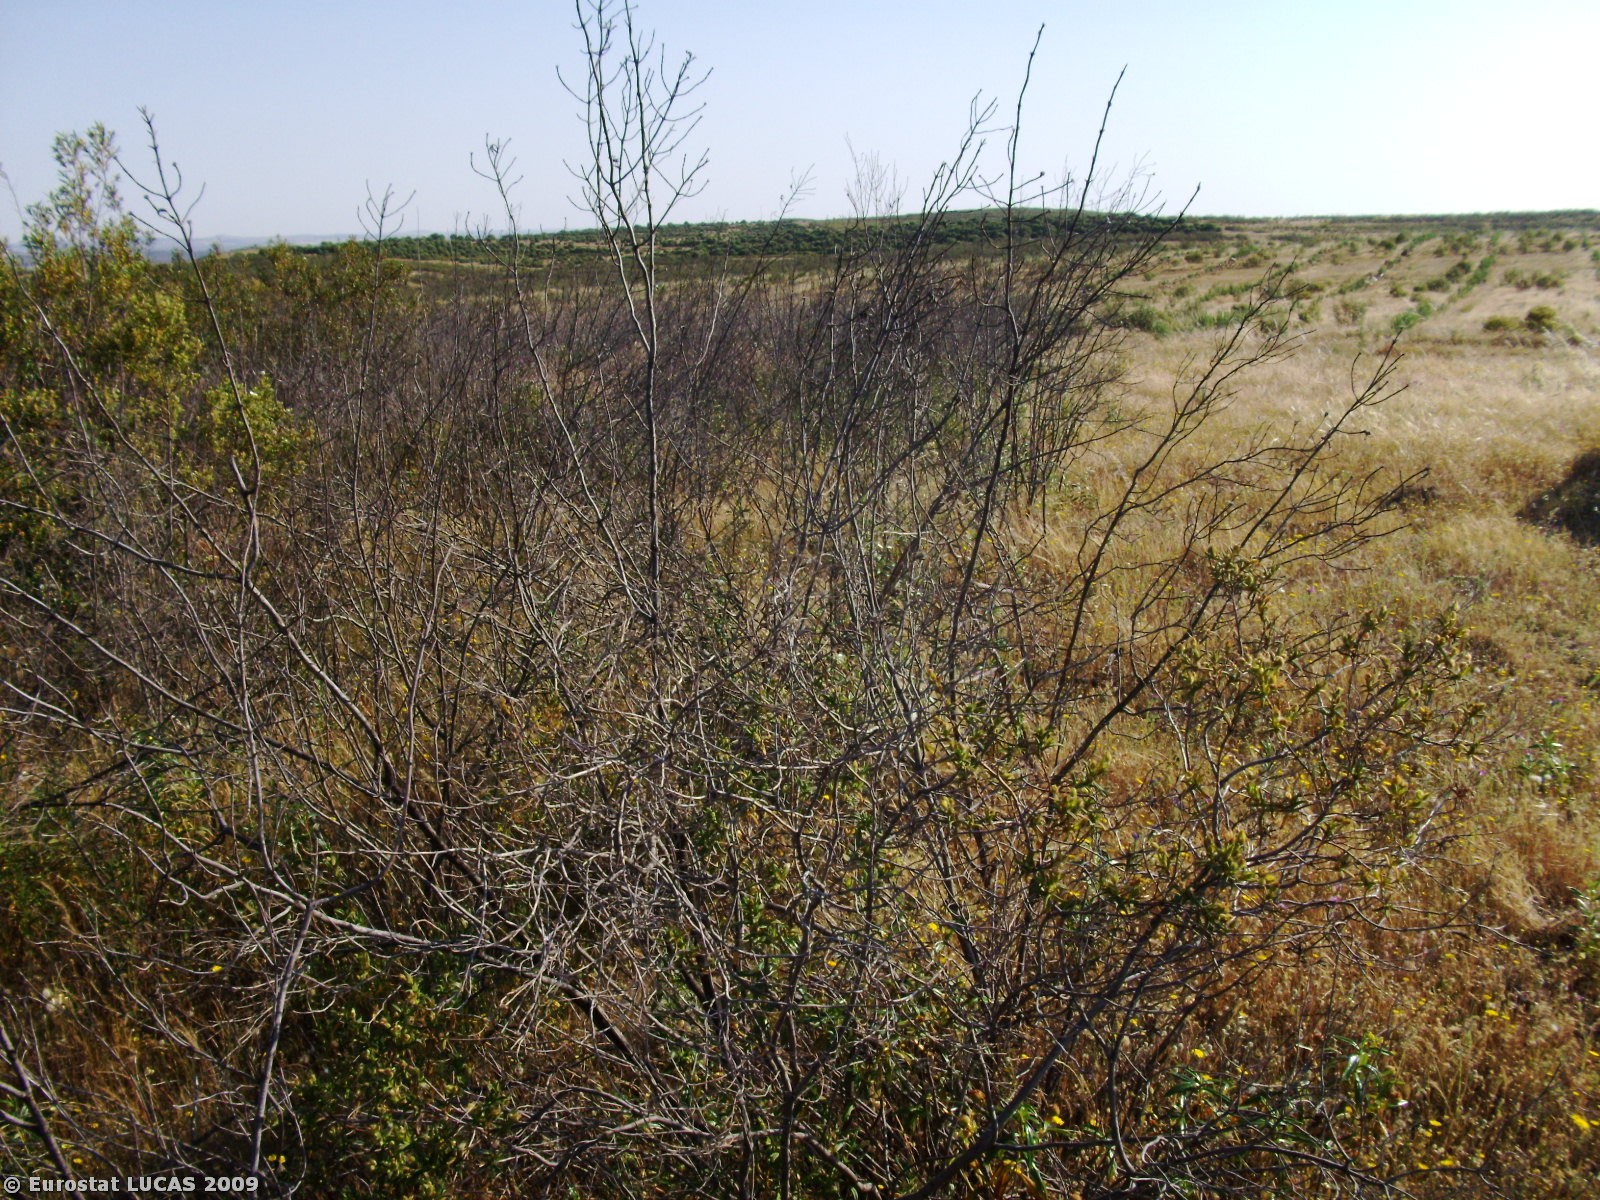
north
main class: Grassland
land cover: Spontaneously vegetated surfaces
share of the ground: 50 - 75 %
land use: Fallow land
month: May
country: PT
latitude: 37.4802
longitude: -7.5957
